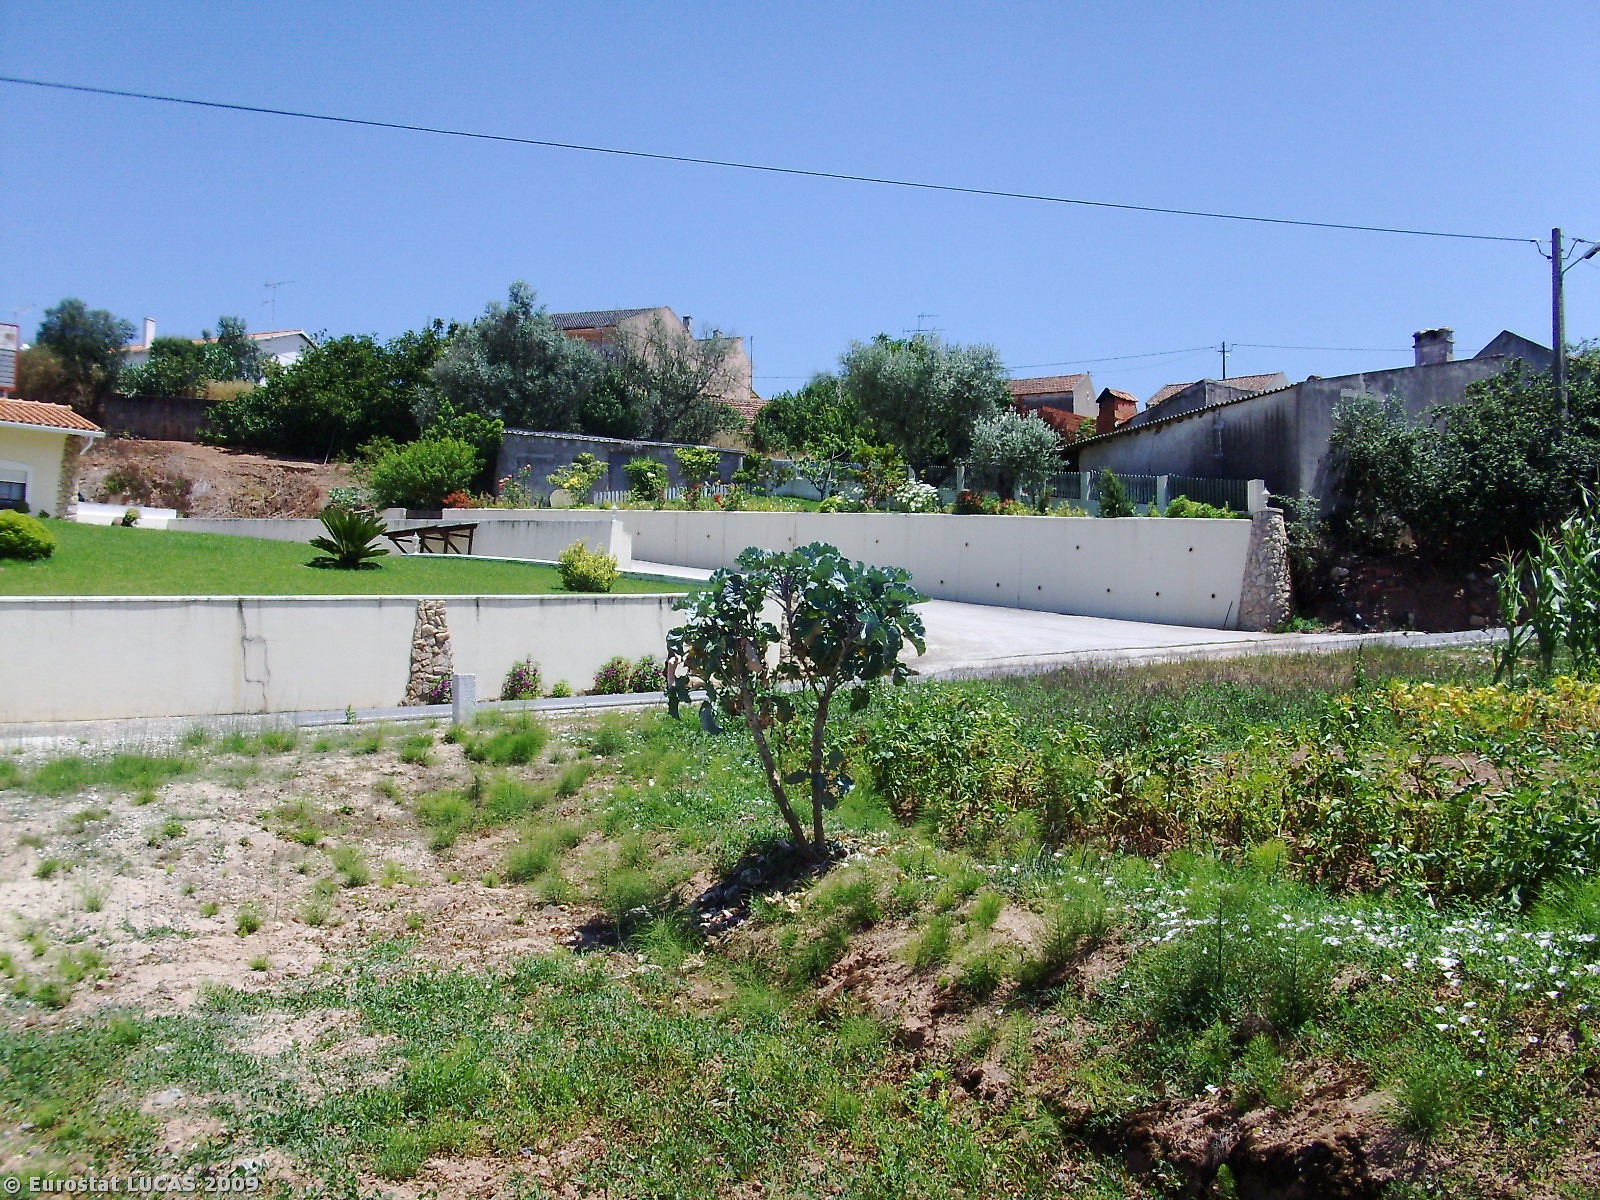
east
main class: Cropland
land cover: Pear fruit
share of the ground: 10 - 25 %
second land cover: Bare land
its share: 50 - 75 %
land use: Agriculture (excluding fallow land and kitchen gardens)
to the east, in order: Pear fruit; Bare land; Electric lines; Potatoes; Paved roads, cycling and walking lanes; Electric lines; Artificial constructions in urban areas; Spontaneously vegetated surfaces; Artificial constructions in urban areas; Electric lines; Paved roads, cycling and walking lanes; Artificial constructions in urban areas; Shrubland without tree cover; Permanent crops (only in case pi)
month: July
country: PT
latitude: 39.5671
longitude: -8.9554
